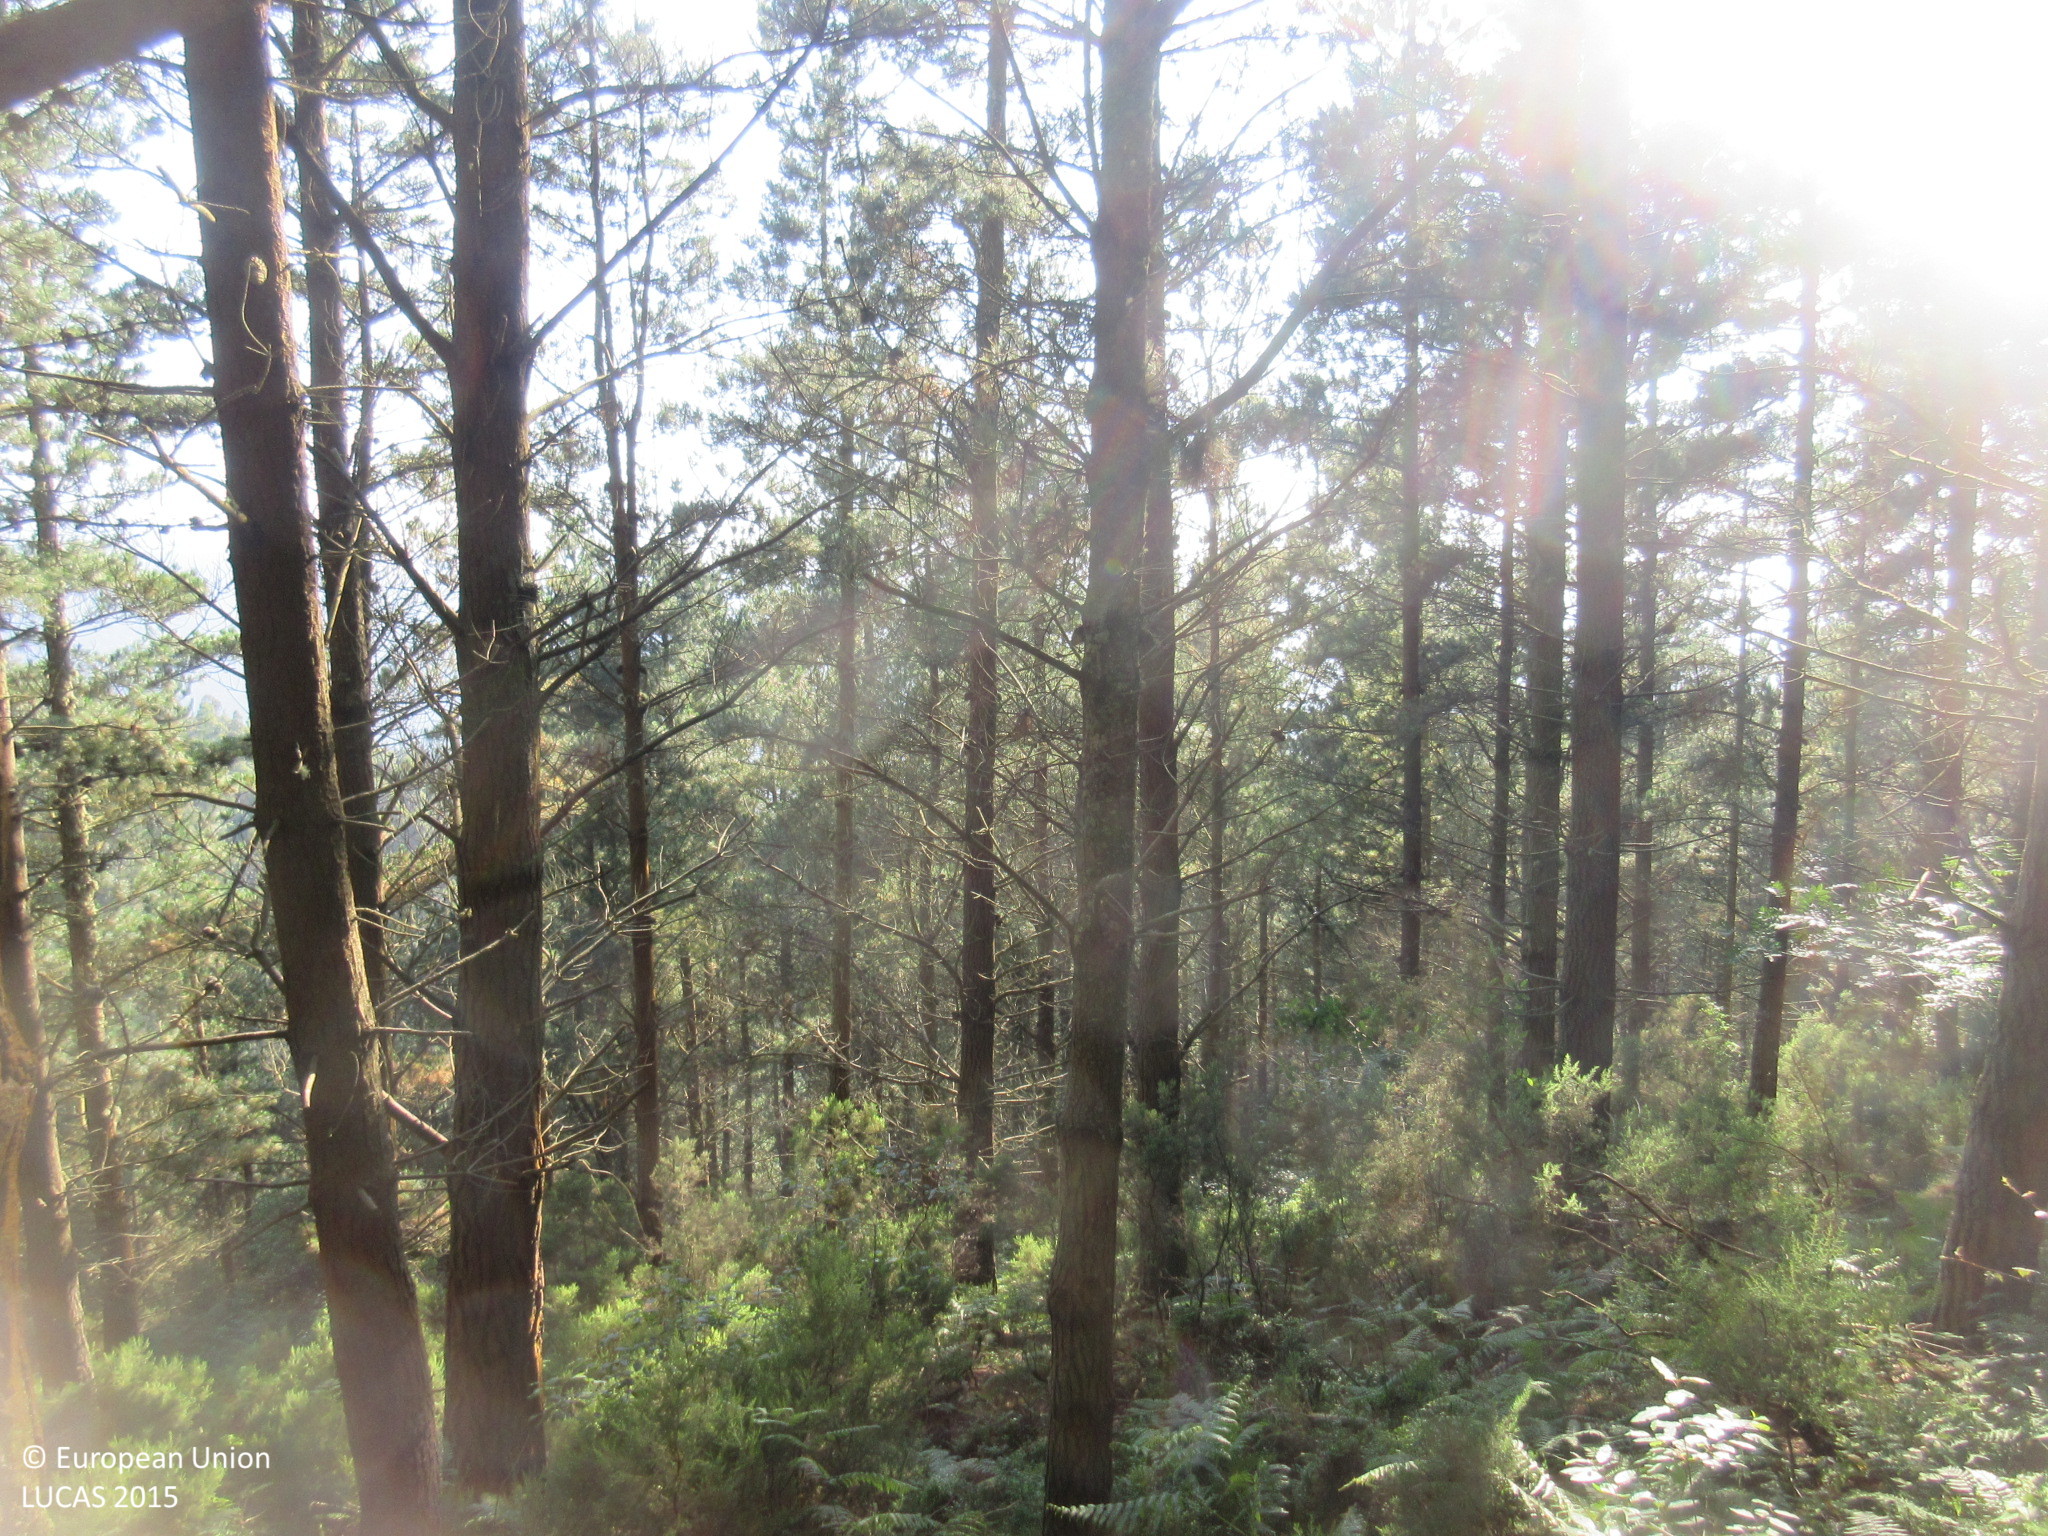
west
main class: Woodland
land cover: Pine dominated coniferous woodland
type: hemiboreal forest and nemoral coniferous forest and mixed broadleaved-coniferous forest
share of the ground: > 75 %
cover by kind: coniferous forest trees 95 %, shrubs 5 %
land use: Forestry
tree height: > 5 m
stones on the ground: > 50 %
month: June
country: ES
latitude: 43.4058
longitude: -7.0470
